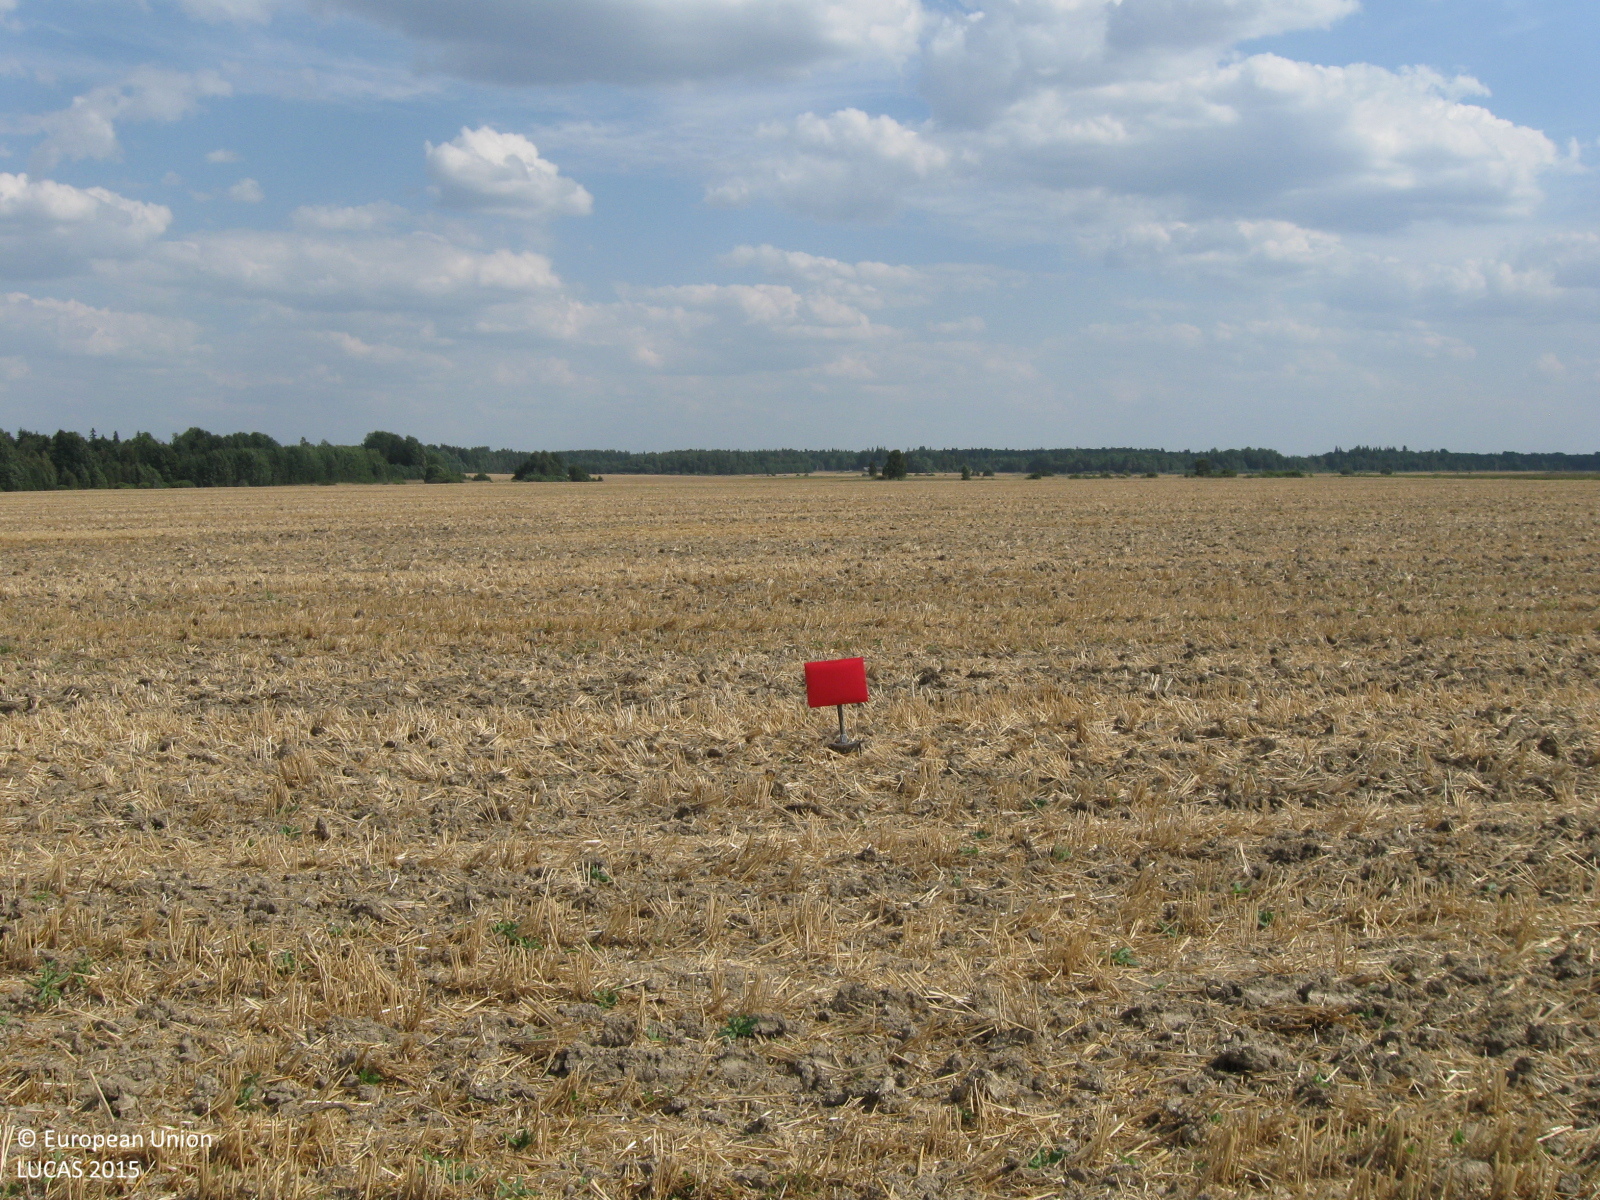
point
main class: Cropland
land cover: Common wheat
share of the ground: < 10 %
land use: Agriculture (excluding fallow land and kitchen gardens)
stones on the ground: < 10 %
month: August
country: LT
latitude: 55.5169
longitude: 22.8800
